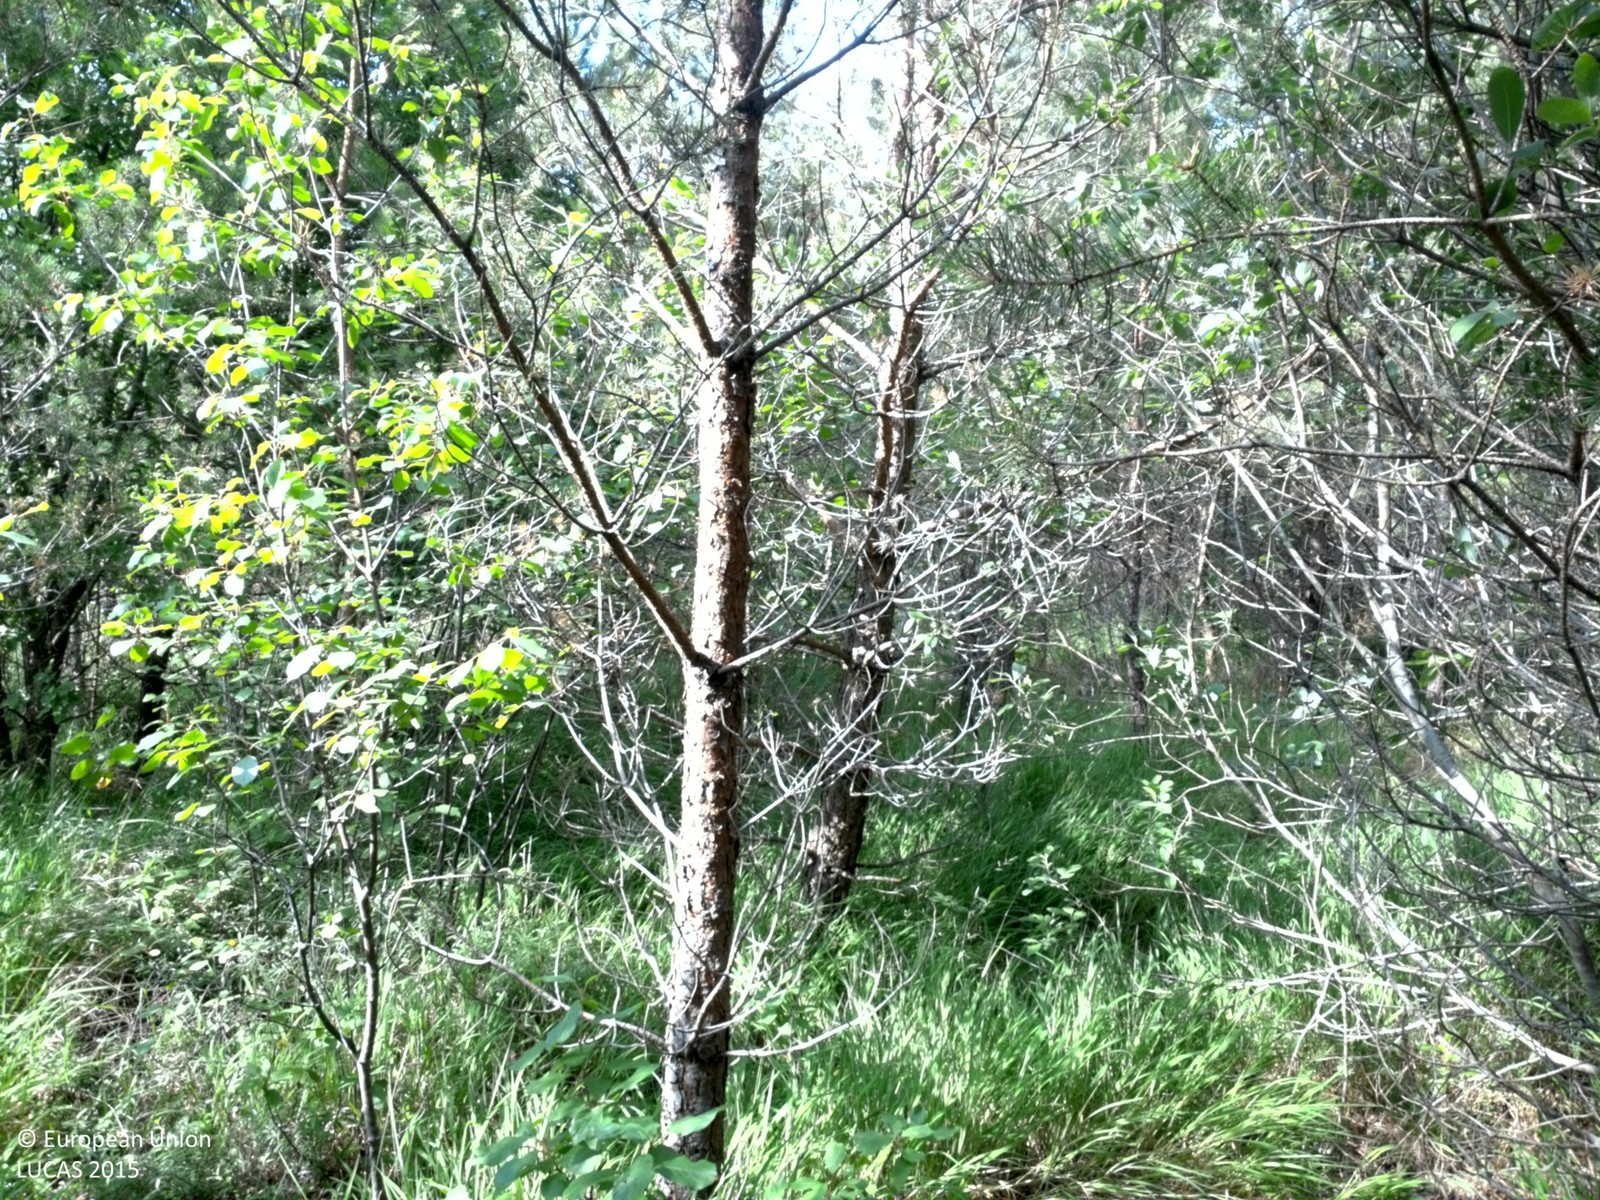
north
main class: Woodland
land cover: Pine dominated mixed woodland
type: hemiboreal forest and nemoral coniferous forest and mixed broadleaved-coniferous forest
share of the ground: > 75 %
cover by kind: coniferous forest trees 55 %, broadleaved forest trees 25 %, herbaceous plants 20 %
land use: Forestry
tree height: < 5 m
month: July
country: SE
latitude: 57.4288
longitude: 18.7209
